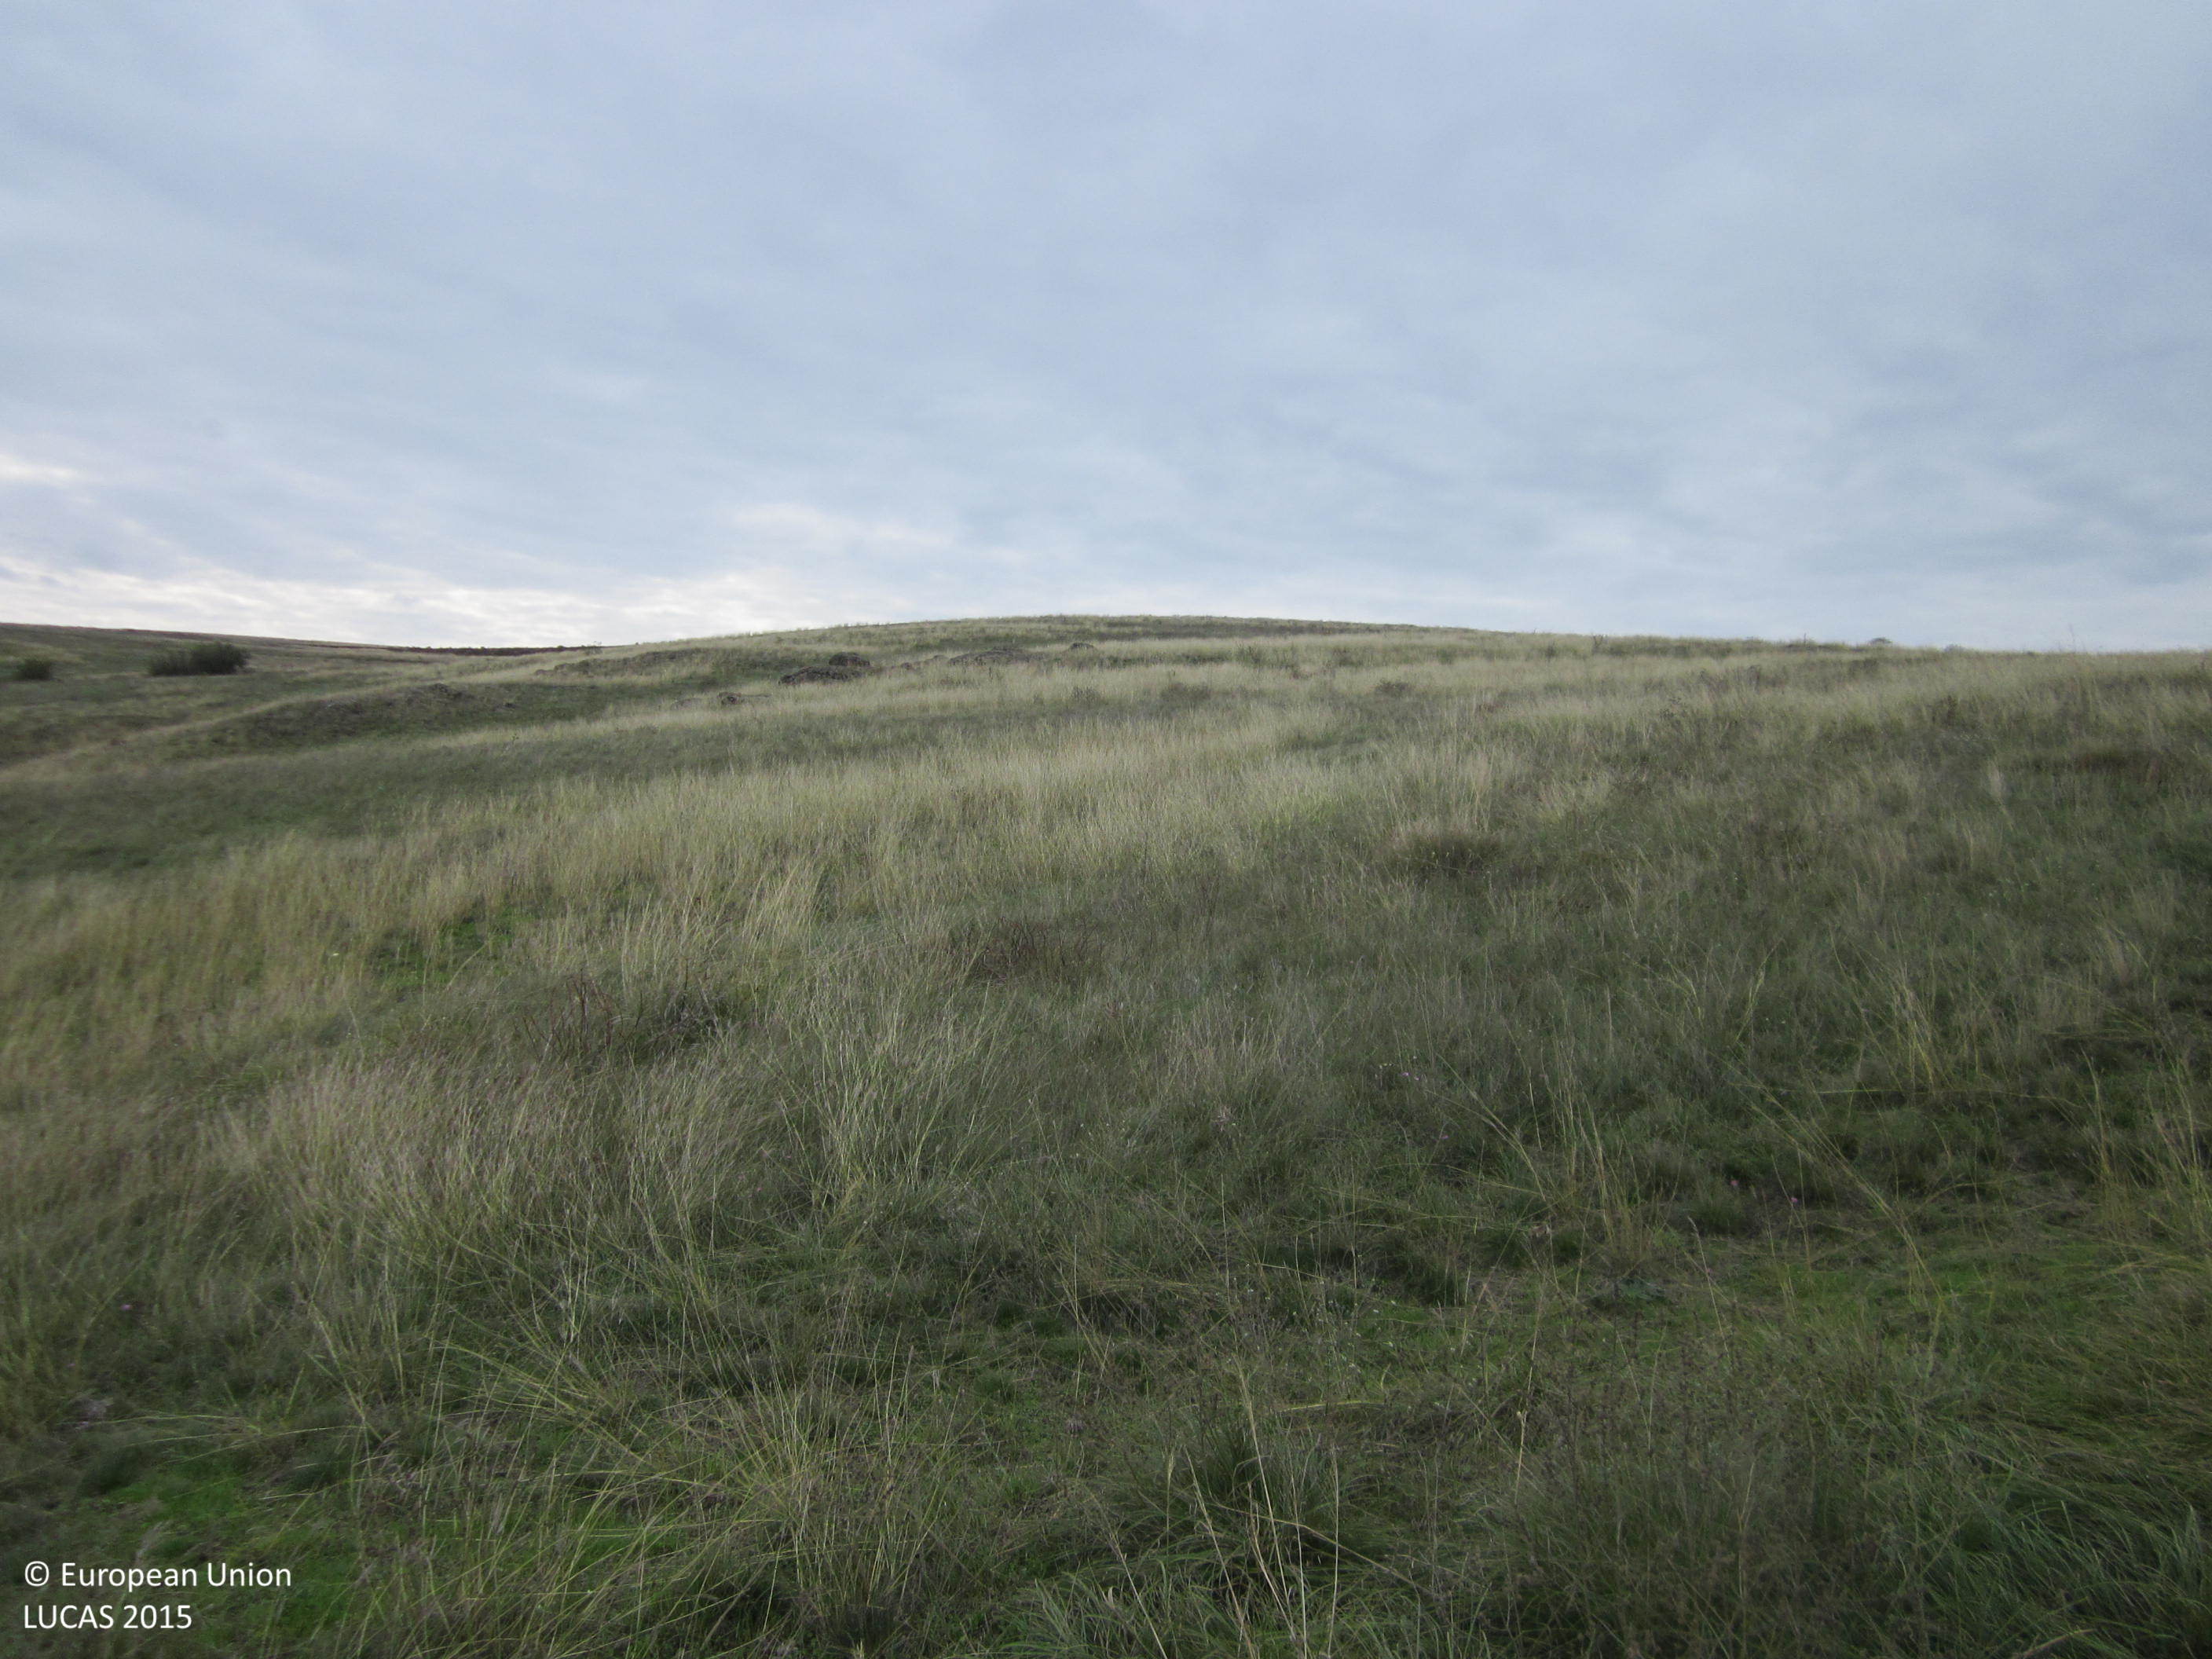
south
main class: Grassland
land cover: Grassland without tree/shrub cover
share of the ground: > 75 %
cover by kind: herbaceous plants 100 %
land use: Agriculture (excluding fallow land and kitchen gardens)
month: October
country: BG
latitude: 42.6357
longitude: 26.9212
